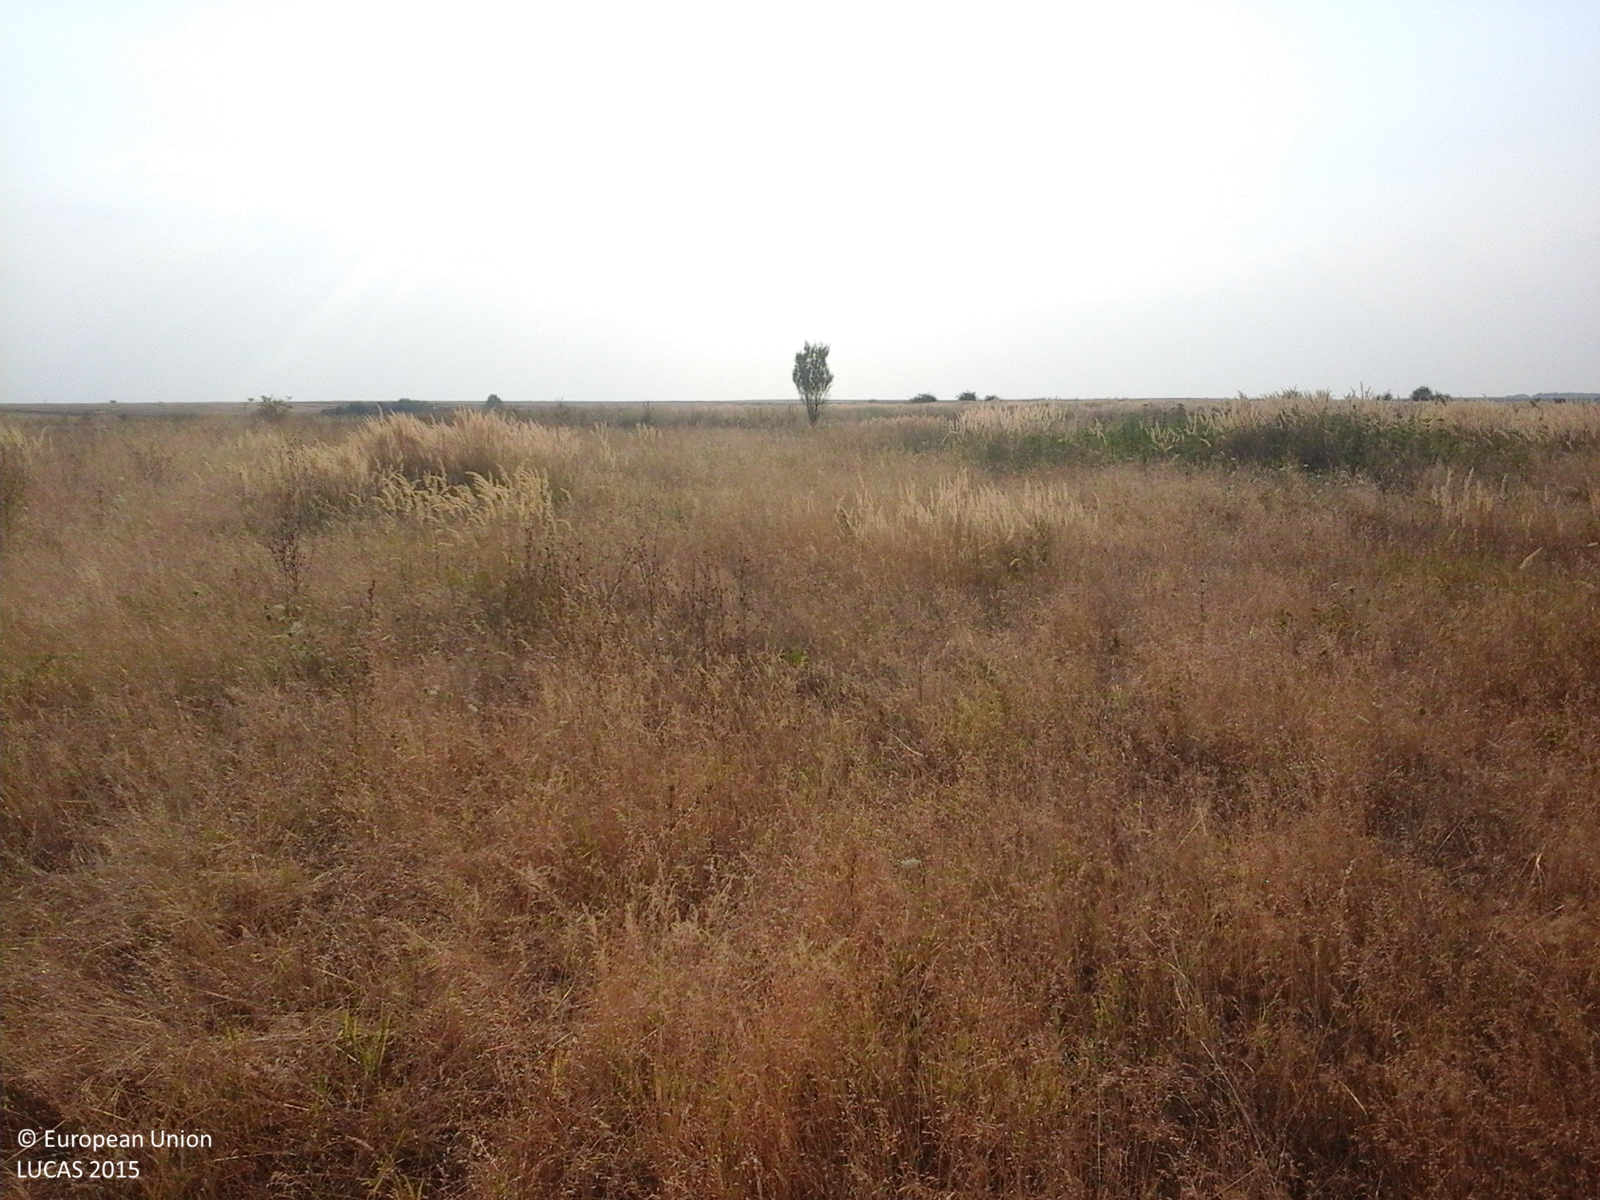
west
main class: Grassland
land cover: Grassland without tree/shrub cover
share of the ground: > 75 %
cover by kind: herbaceous plants 100 %
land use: Agriculture (excluding fallow land and kitchen gardens)
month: August
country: RO
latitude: 44.4414
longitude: 22.9989
